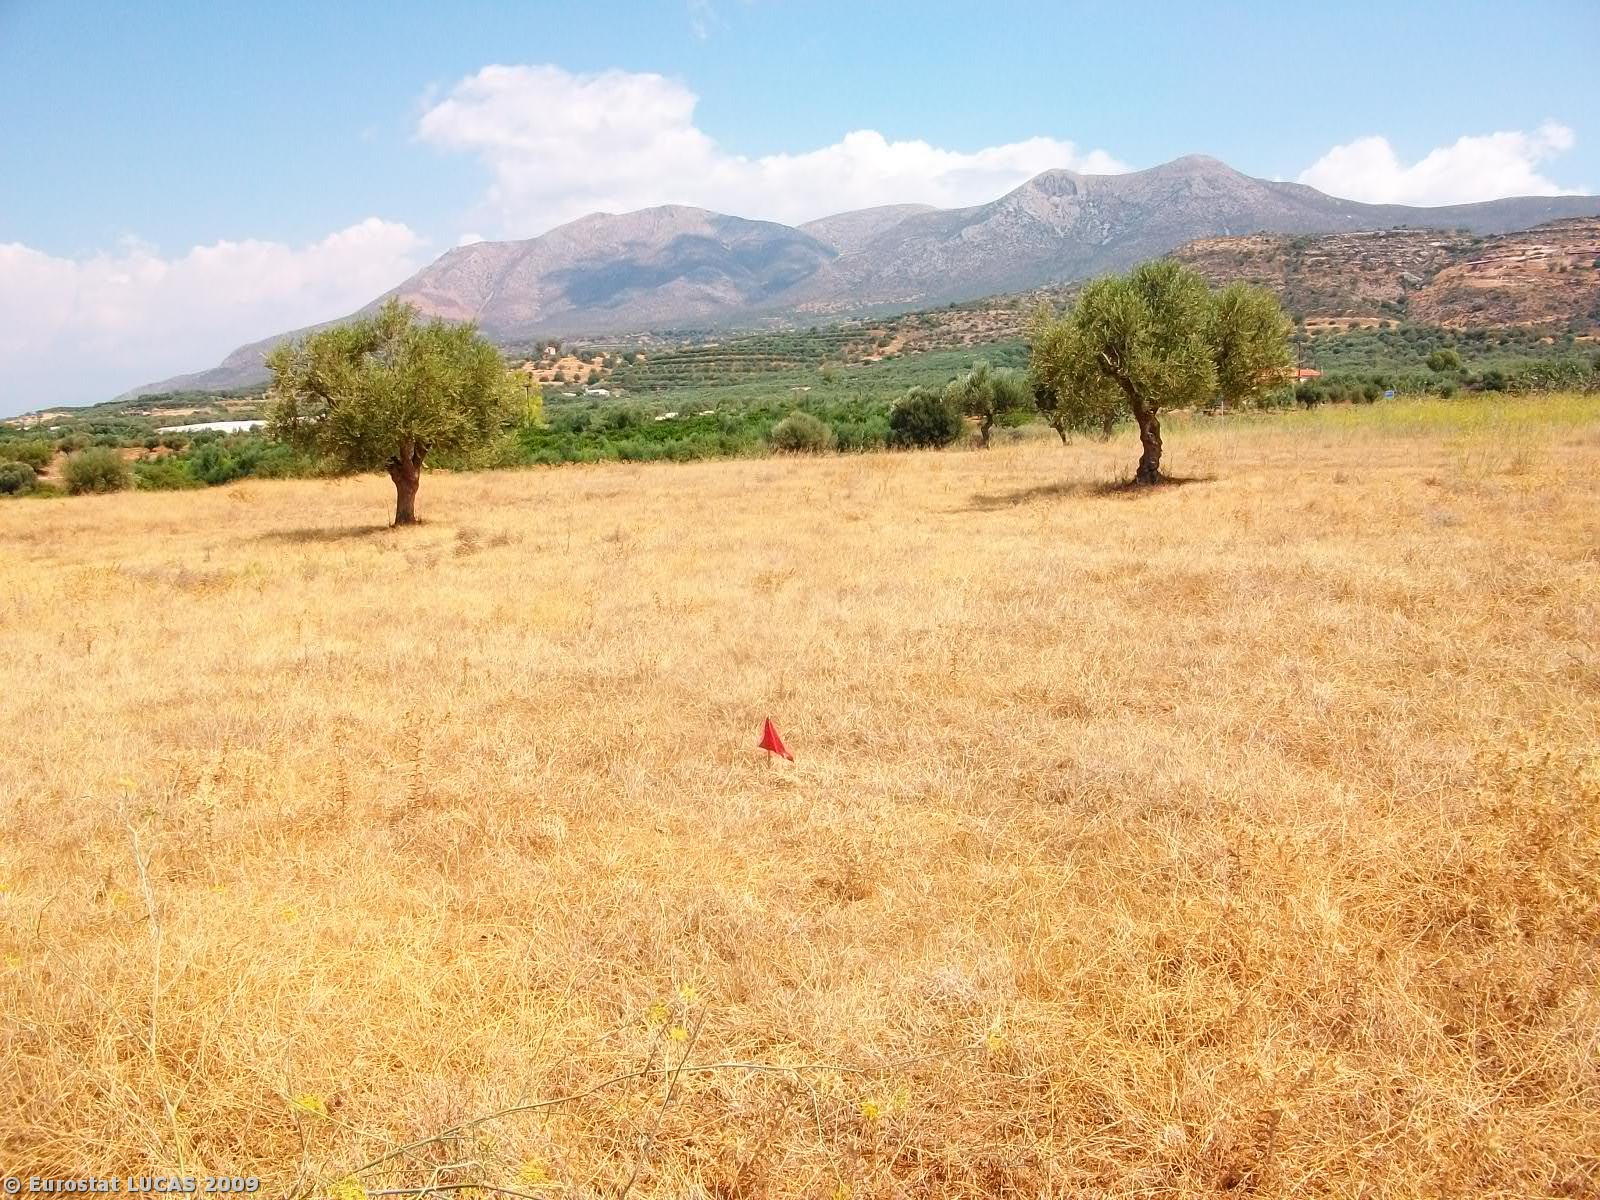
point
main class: Grassland
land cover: Grassland with sparse tree/shrub cover
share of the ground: > 75 %
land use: Agriculture (excluding fallow land and kitchen gardens)
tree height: < 5 m
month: August
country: GR
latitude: 36.7681
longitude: 22.8038
